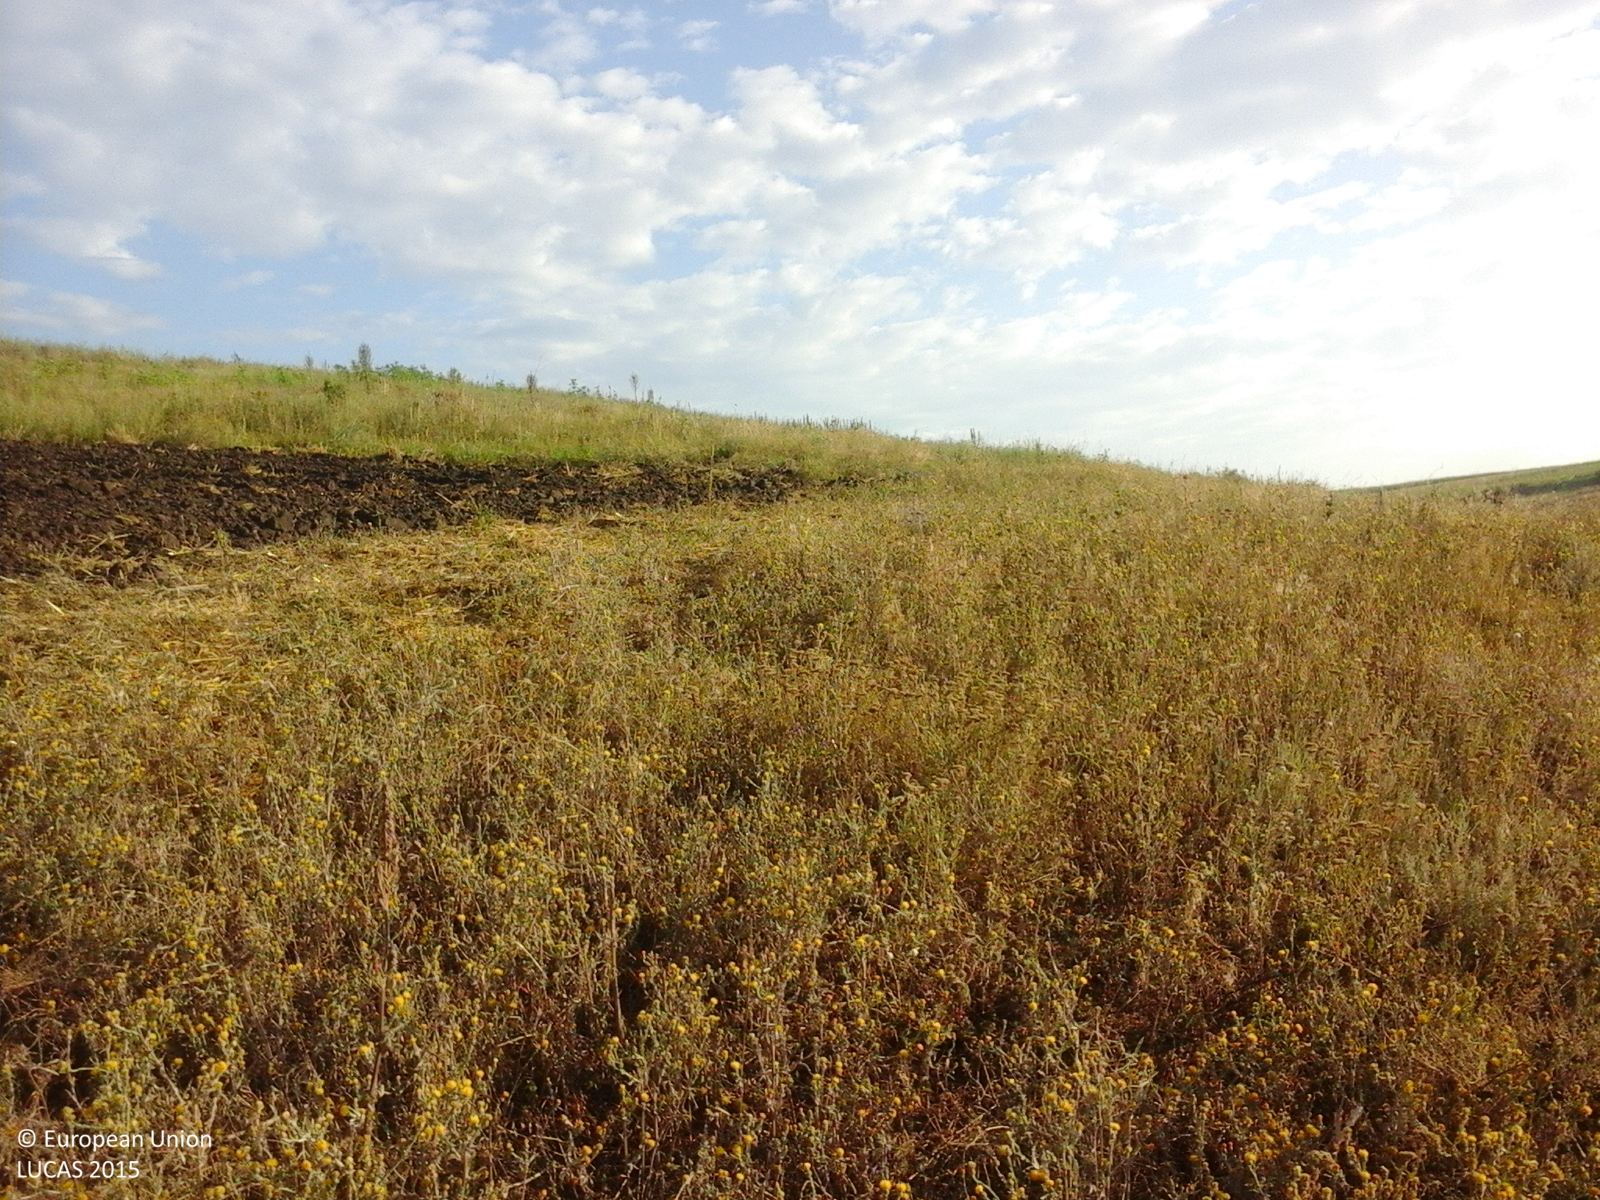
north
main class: Grassland
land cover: Grassland without tree/shrub cover
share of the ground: > 75 %
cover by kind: herbaceous plants 100 %
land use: Agriculture (excluding fallow land and kitchen gardens)
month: July
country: RO
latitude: 46.2176
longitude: 27.7328
